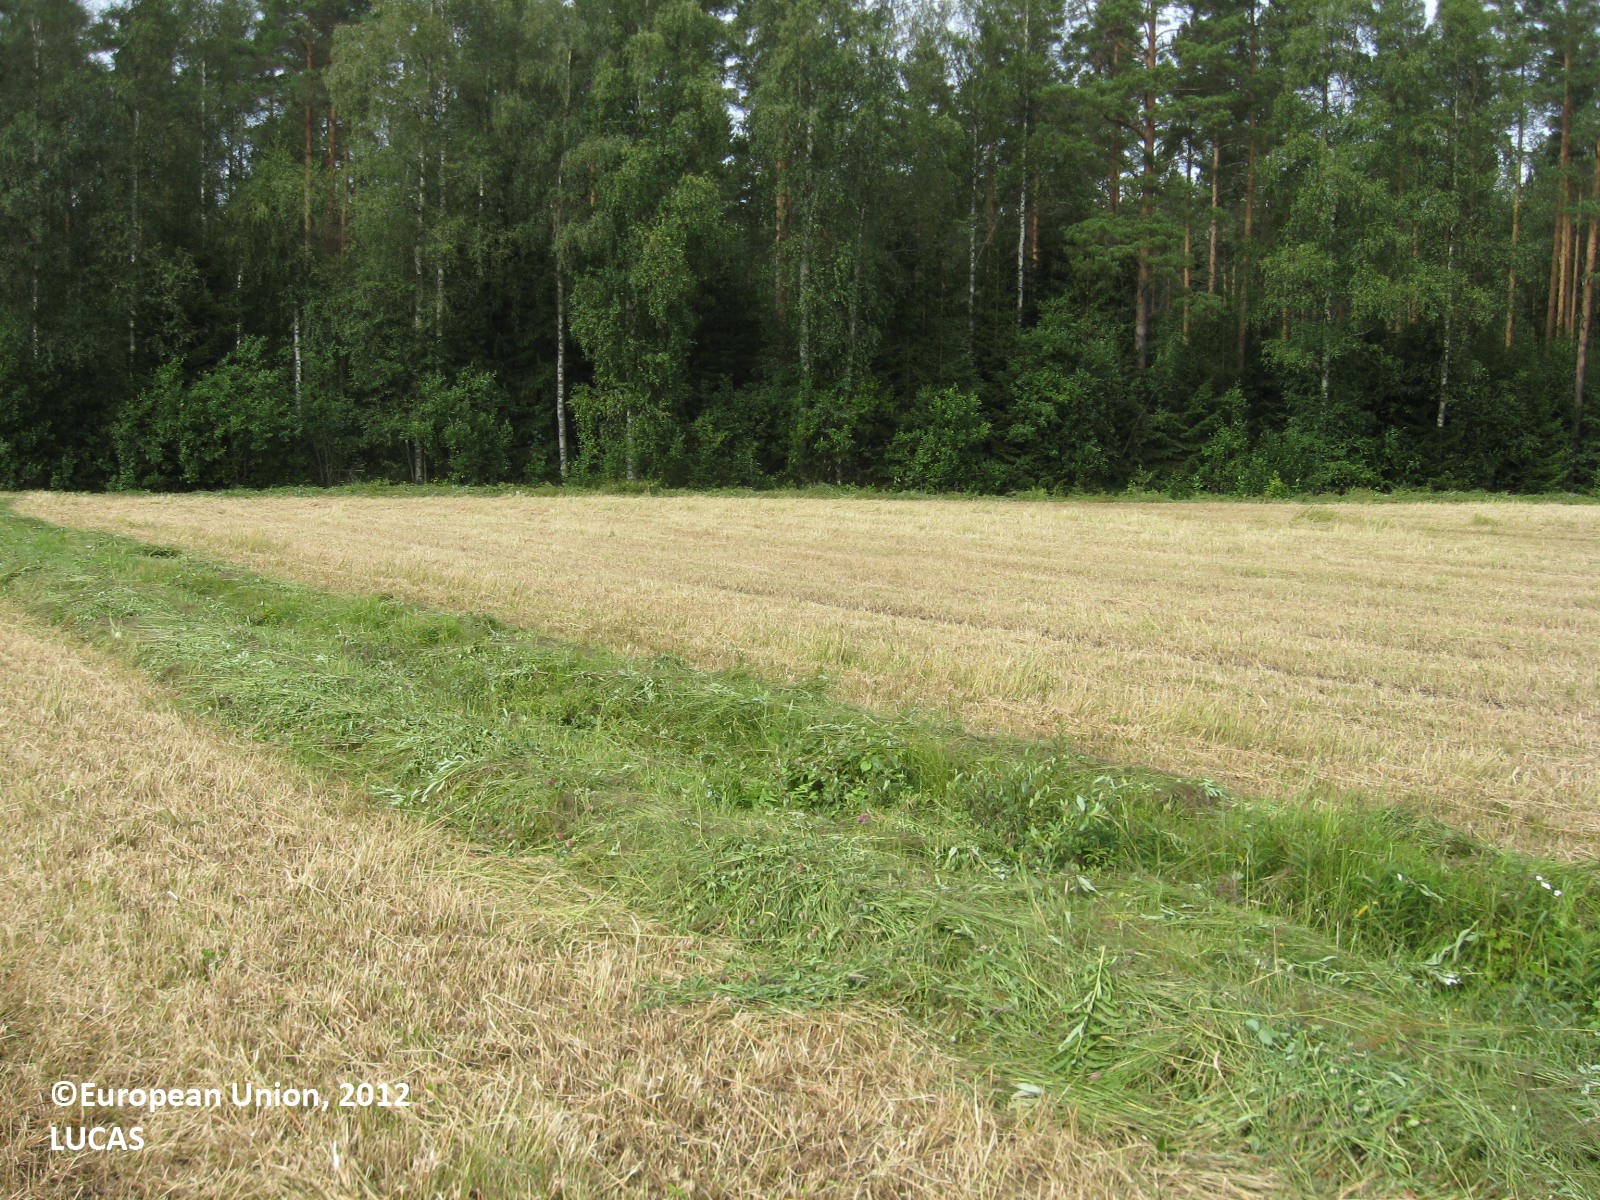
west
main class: Cropland
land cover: Temporary grasslands
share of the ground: > 75 %
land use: Agriculture (excluding fallow land and kitchen gardens)
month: July
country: FI
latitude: 61.9864
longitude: 21.5175
